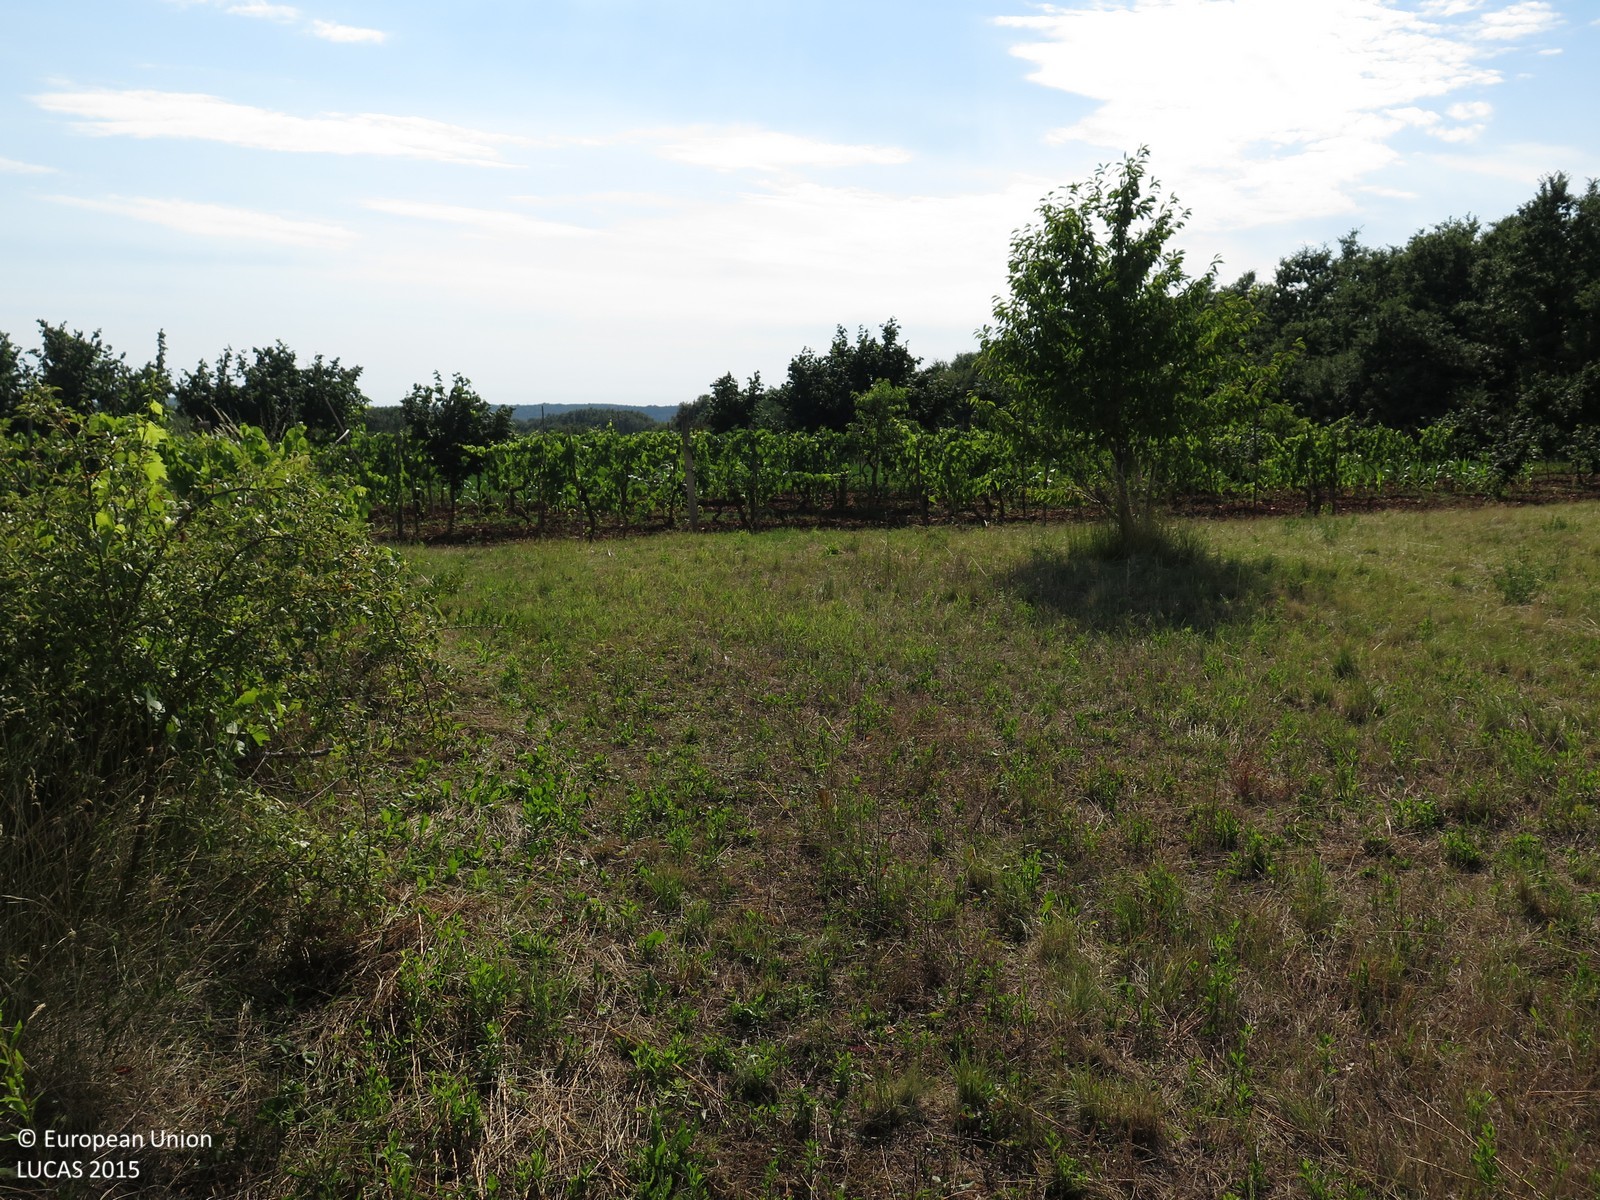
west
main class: Grassland
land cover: Grassland without tree/shrub cover
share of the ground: > 75 %
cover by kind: herbaceous plants 100 %
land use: Agriculture (excluding fallow land and kitchen gardens)
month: June
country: HR
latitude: 45.1627
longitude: 13.8748
